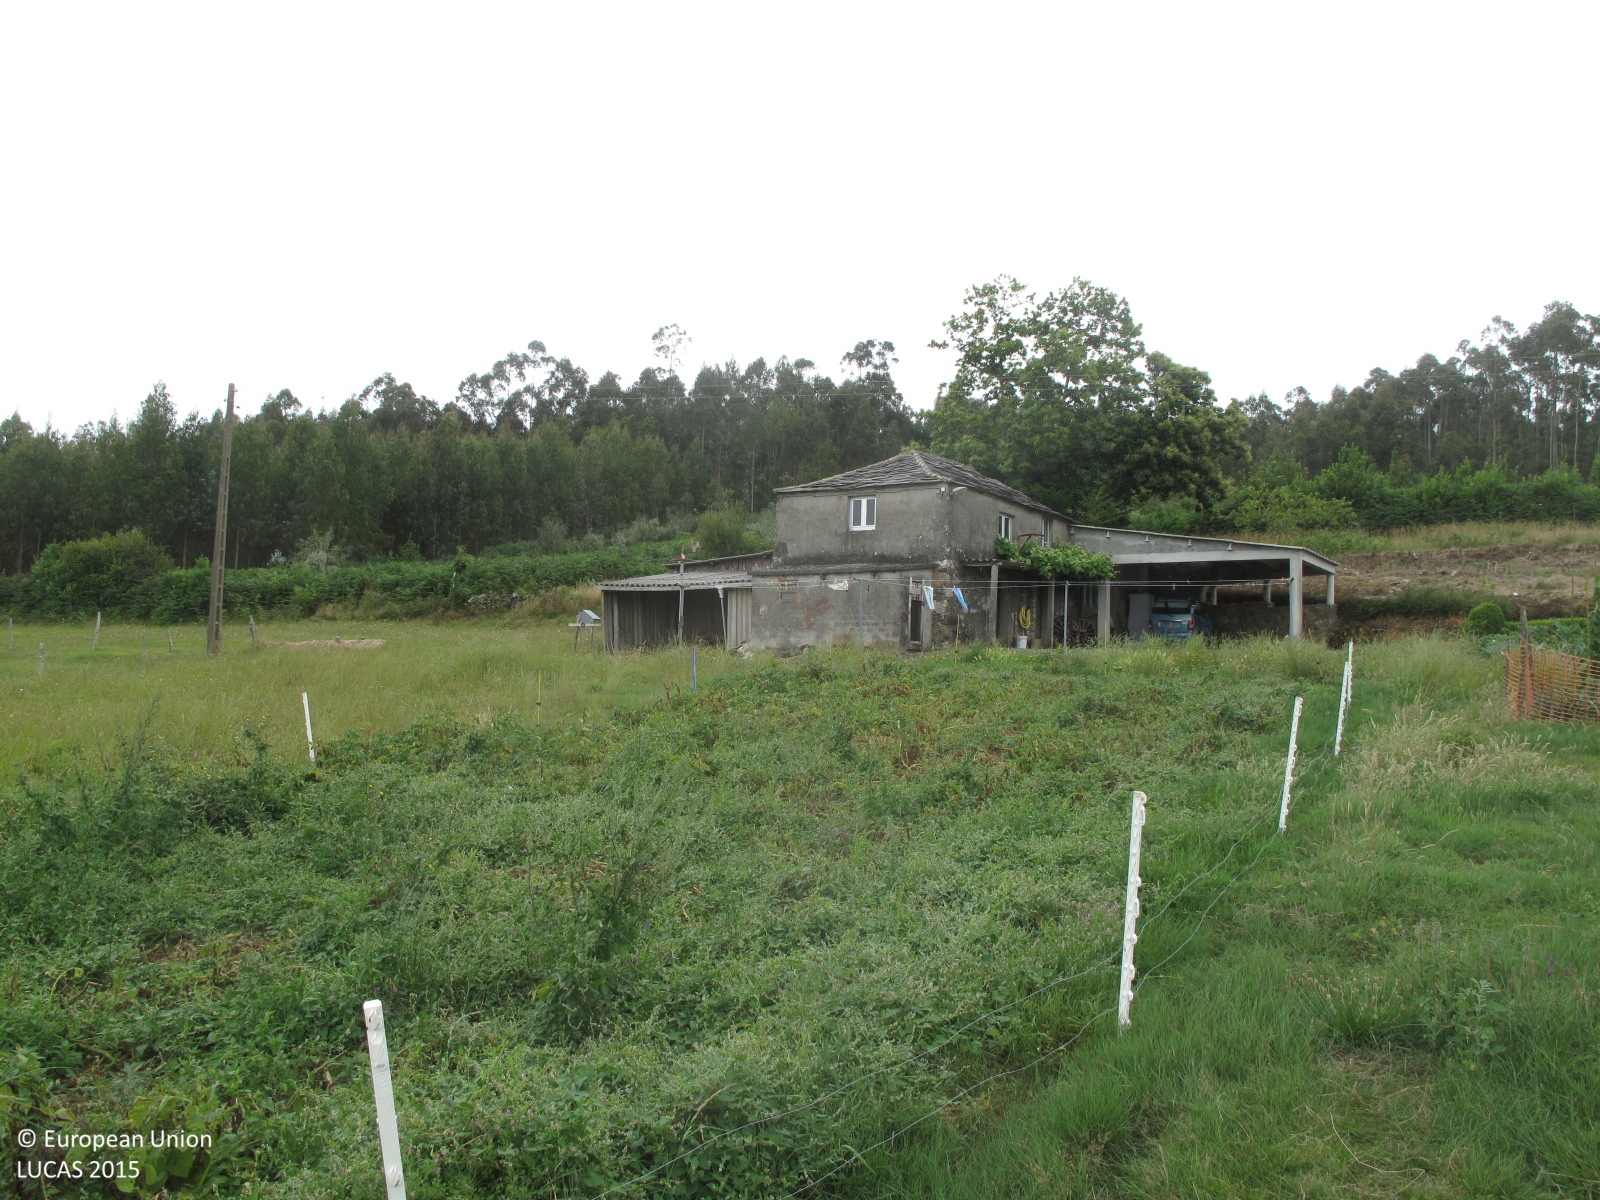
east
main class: Grassland
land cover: Grassland without tree/shrub cover
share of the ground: > 75 %
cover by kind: herbaceous plants 100 %
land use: Agriculture (excluding fallow land and kitchen gardens)
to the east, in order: Grassland without tree/shrub cover; Potatoes; Grassland without tree/shrub cover; Artificial constructions in urban areas; Grassland without tree/shrub cover; Dry stone walls; Shrubland without tree cover; Broadleaved woodland
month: July
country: ES
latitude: 43.6129
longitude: -7.8742
